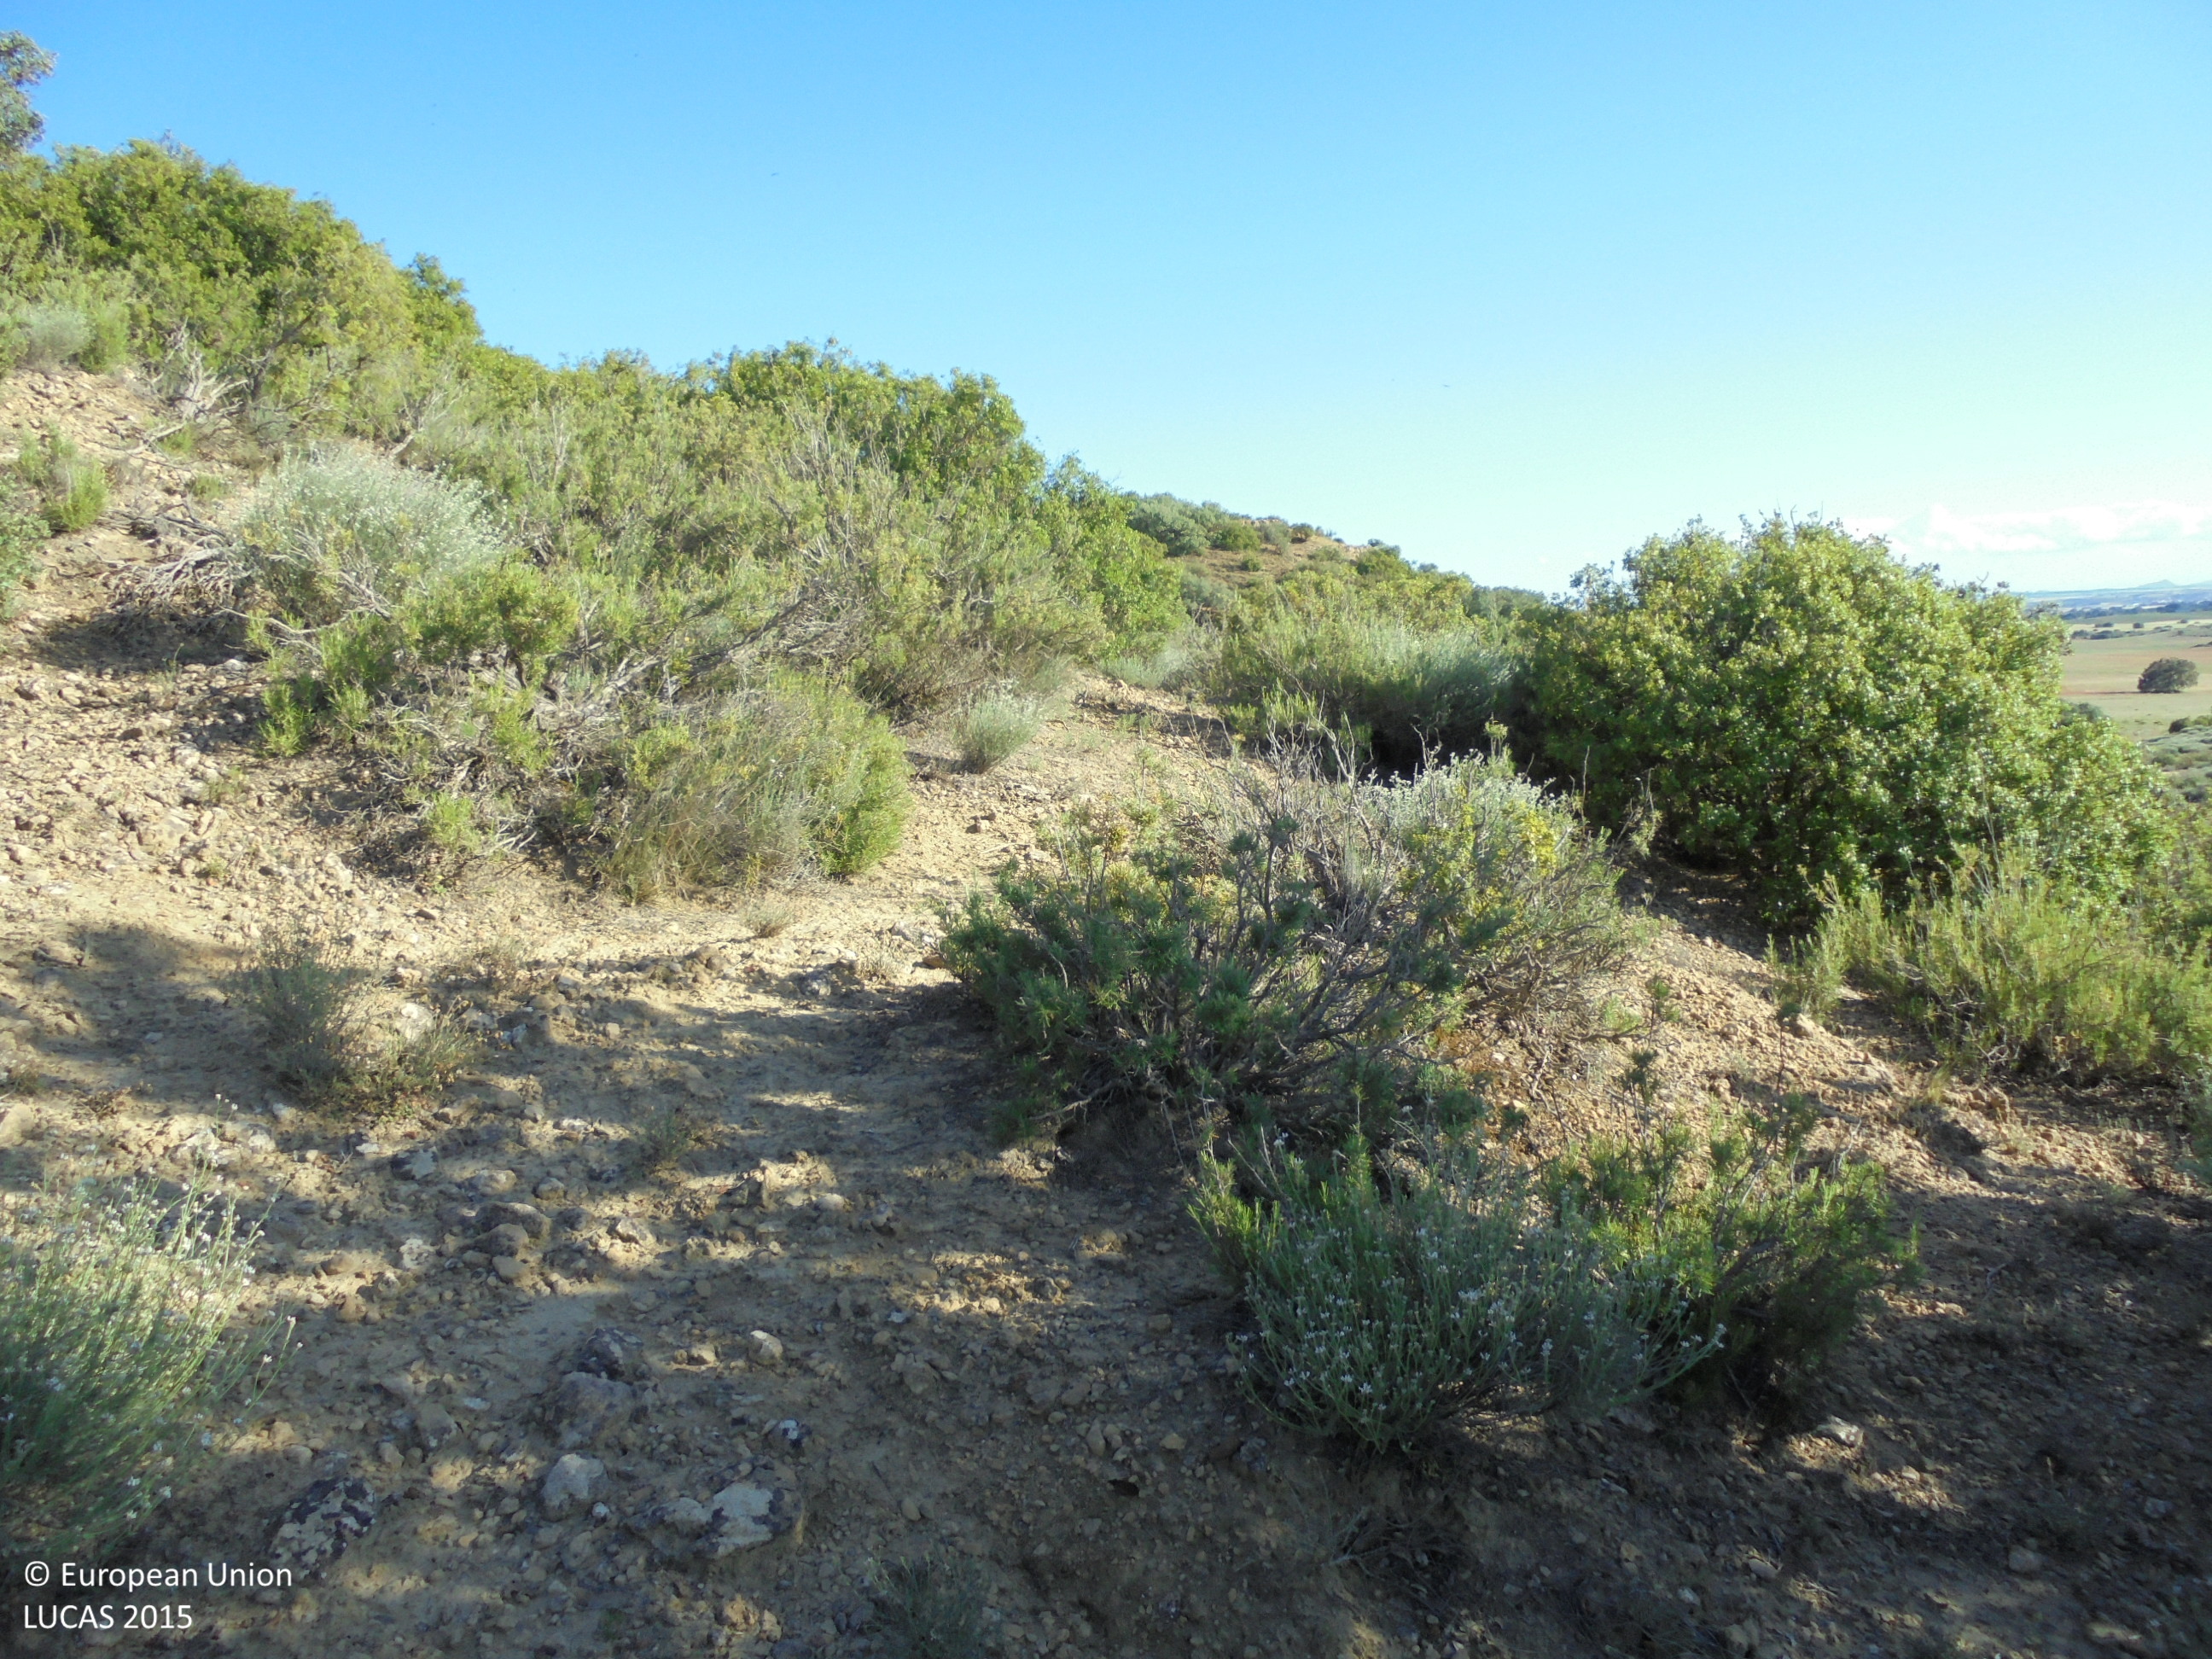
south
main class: Woodland
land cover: Broadleaved woodland
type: broadleaved evergreen forest
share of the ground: 10 - 25 %
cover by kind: shrubs 60 %, broadleaved forest trees 20 %, unconsolidated bare surface 20 %
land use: Semi-natural and natural areas not in use
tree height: < 5 m
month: May
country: ES
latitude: 38.8956
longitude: -1.4919
